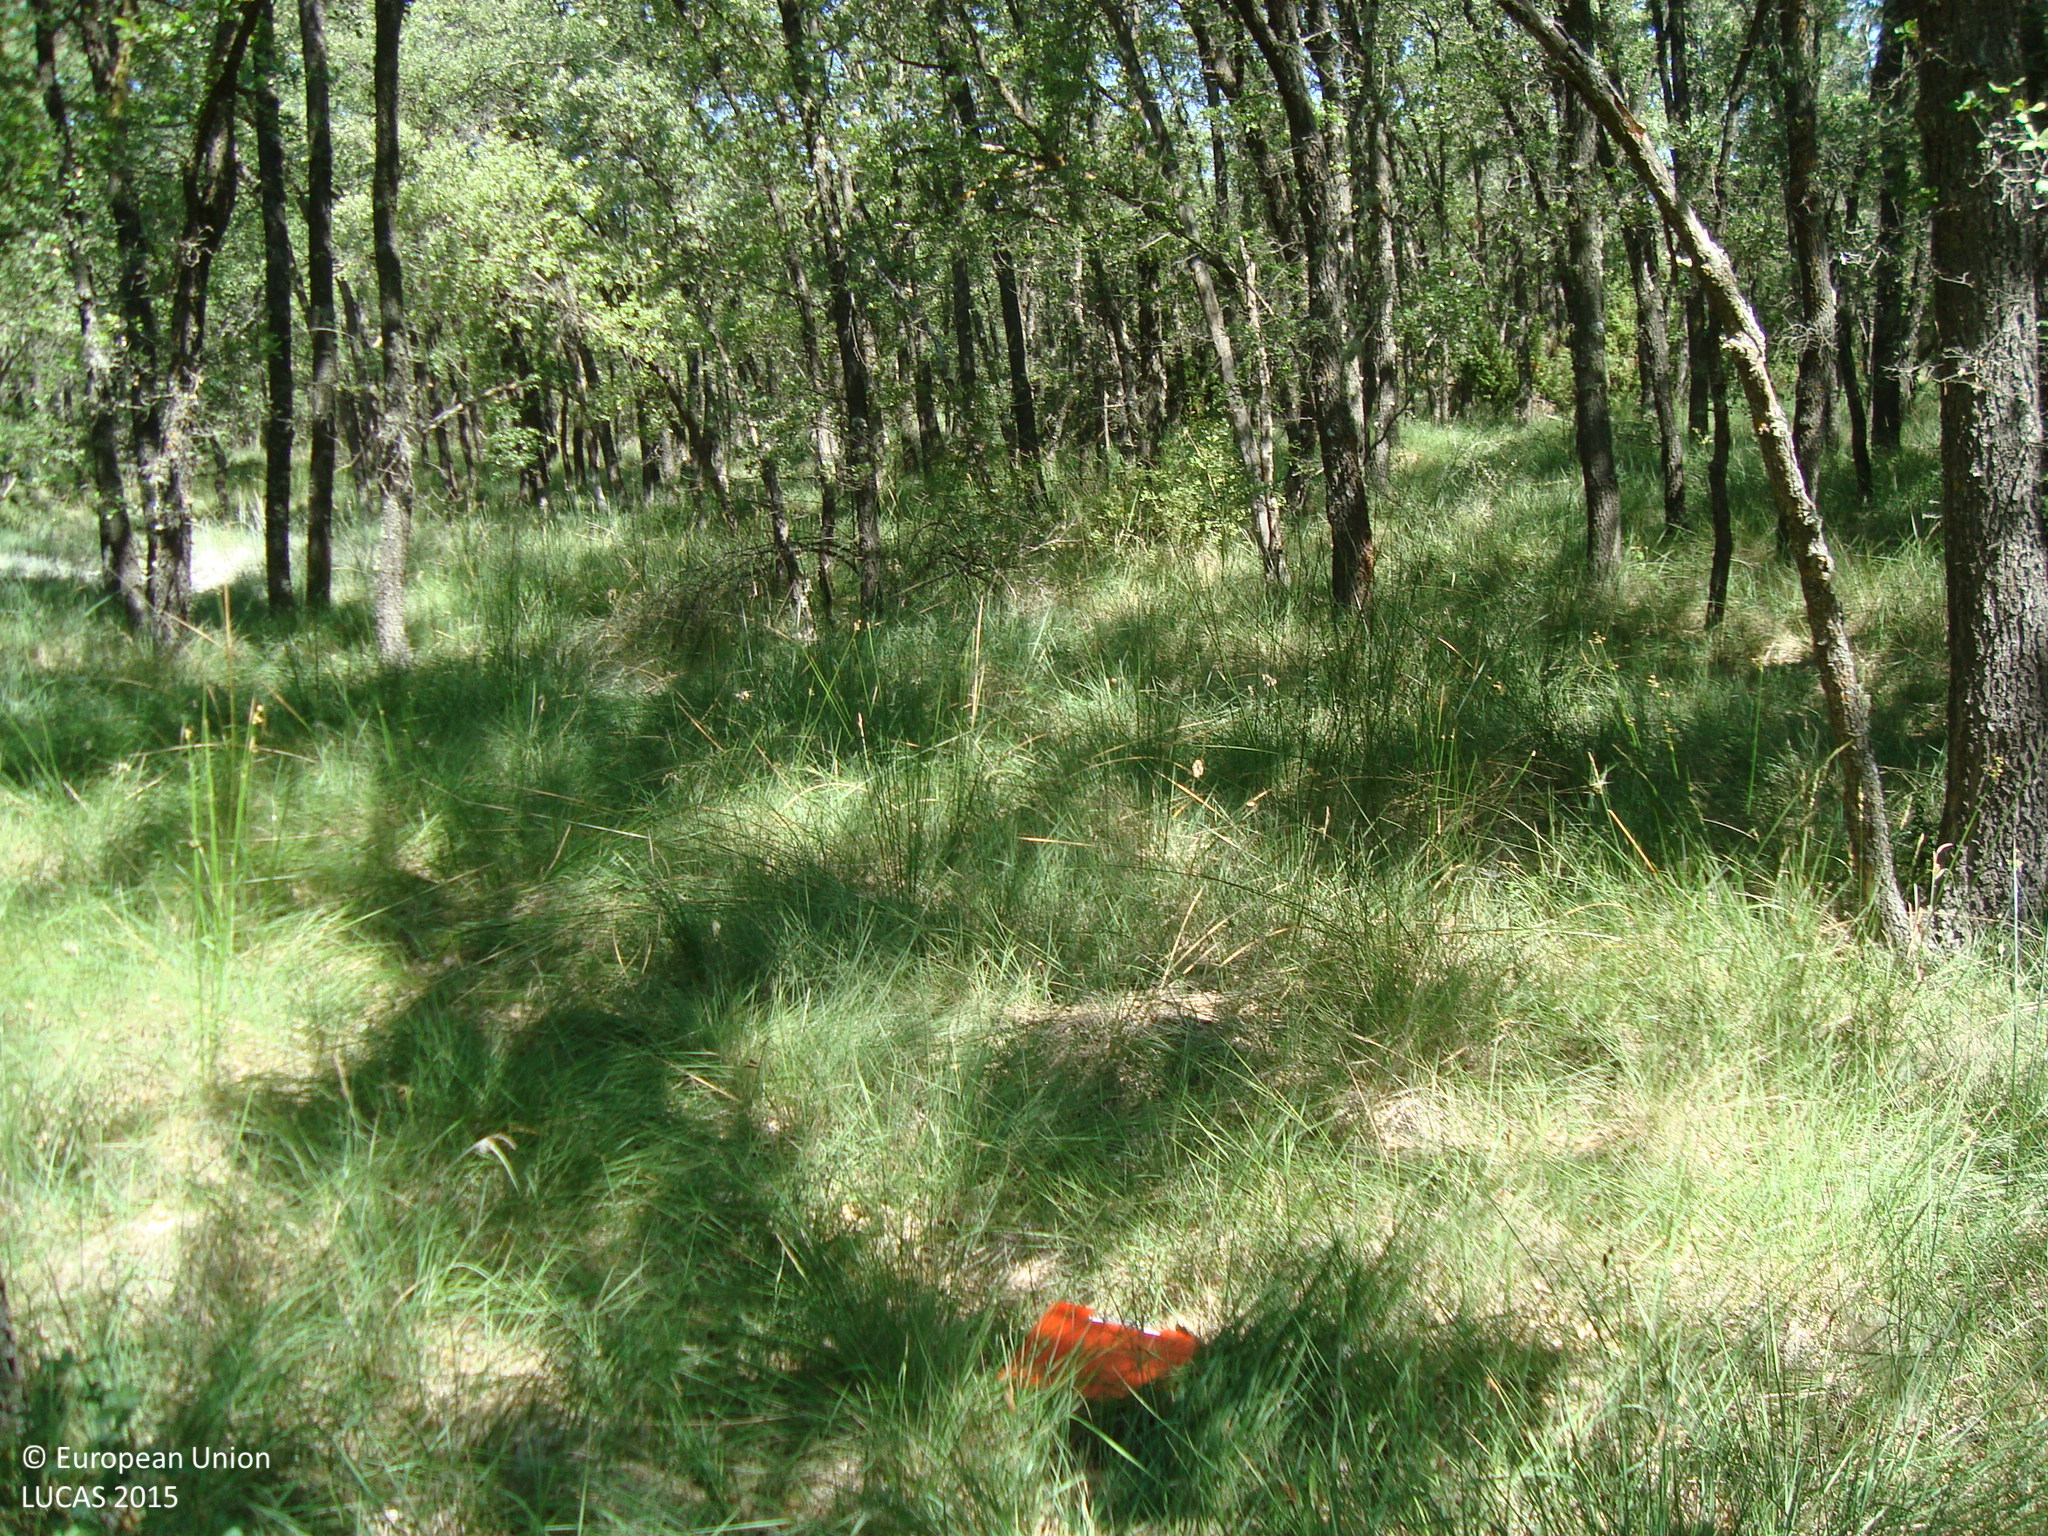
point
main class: Woodland
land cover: Broadleaved woodland
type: thermophilous deciduous forest
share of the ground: > 75 %
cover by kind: broadleaved forest trees 80 %, herbaceous plants 20 %
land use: Forestry
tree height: > 5 m
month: July
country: ES
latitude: 41.8260
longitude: -4.2341
